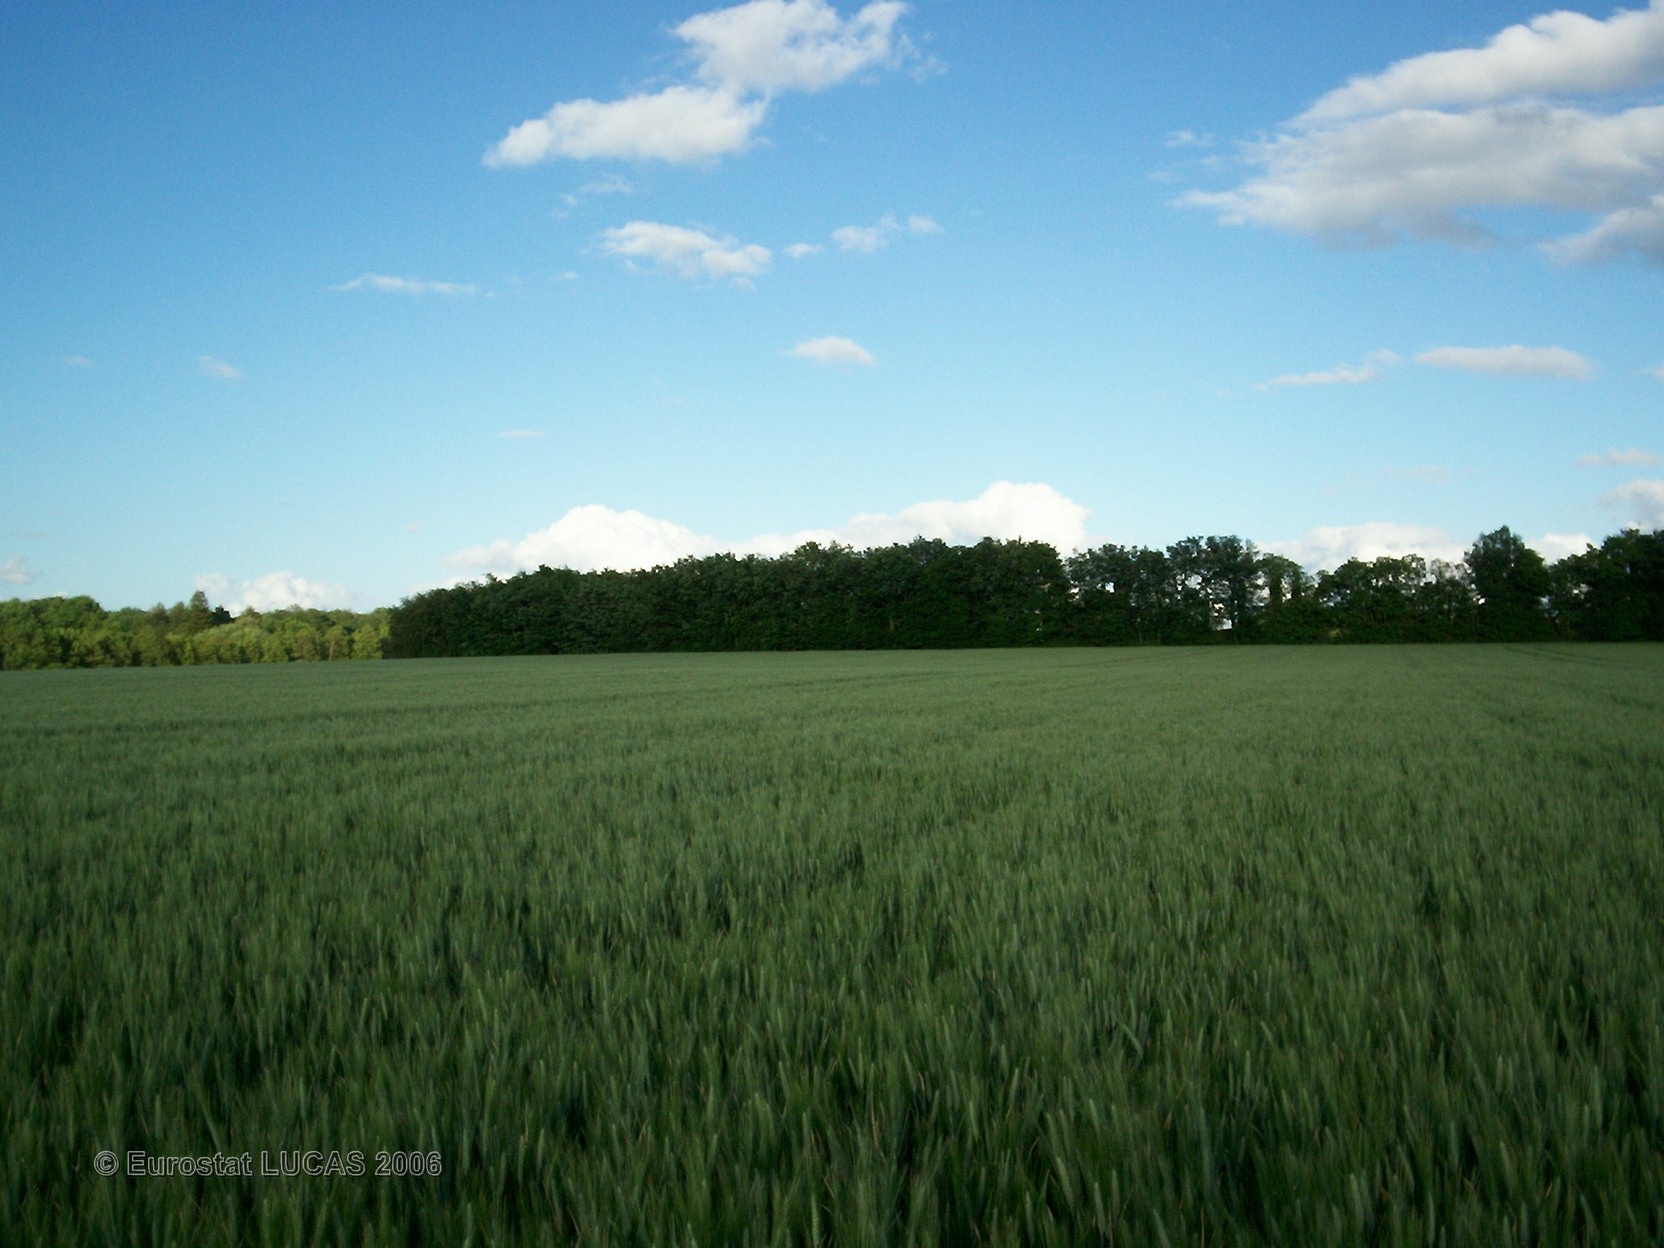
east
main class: Cropland
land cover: Durum wheat
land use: Agriculture (excluding fallow land and kitchen gardens)
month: May
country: FR
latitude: 45.8164
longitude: 0.4745
